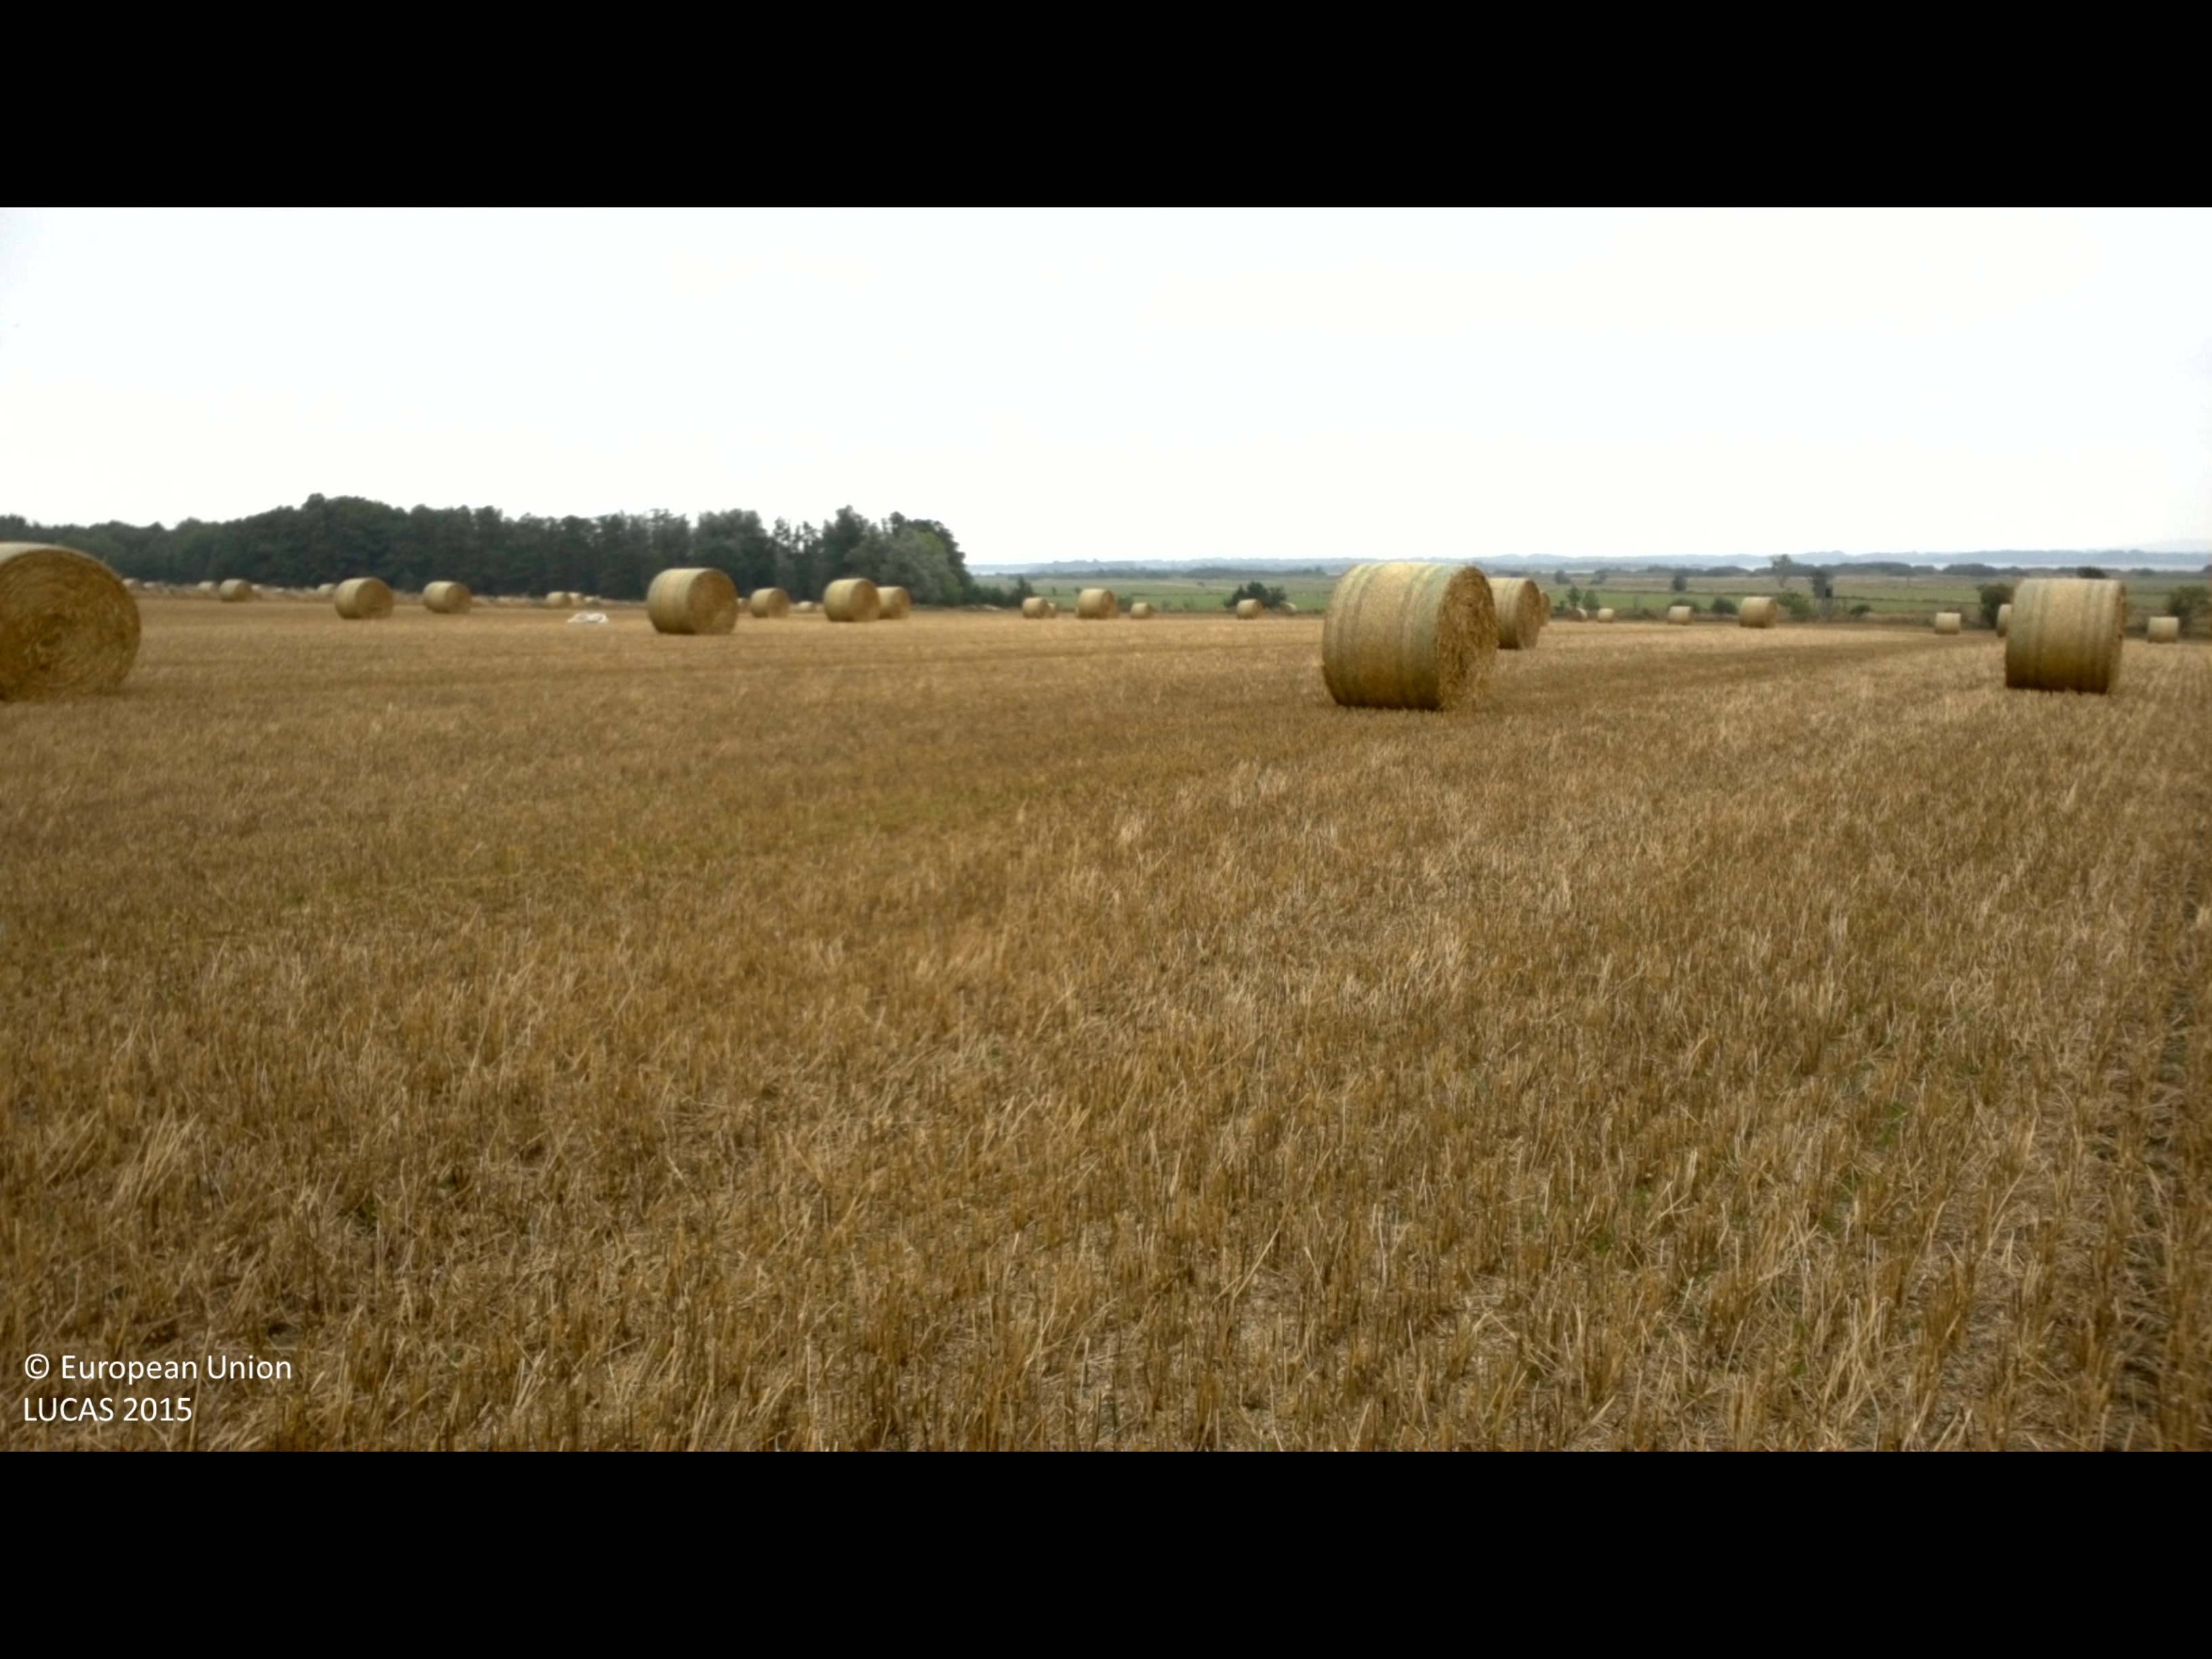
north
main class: Cropland
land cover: Common wheat
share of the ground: > 75 %
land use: Agriculture (excluding fallow land and kitchen gardens)
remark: Harvested field
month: September
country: SE
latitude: 55.9757
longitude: 14.1805
